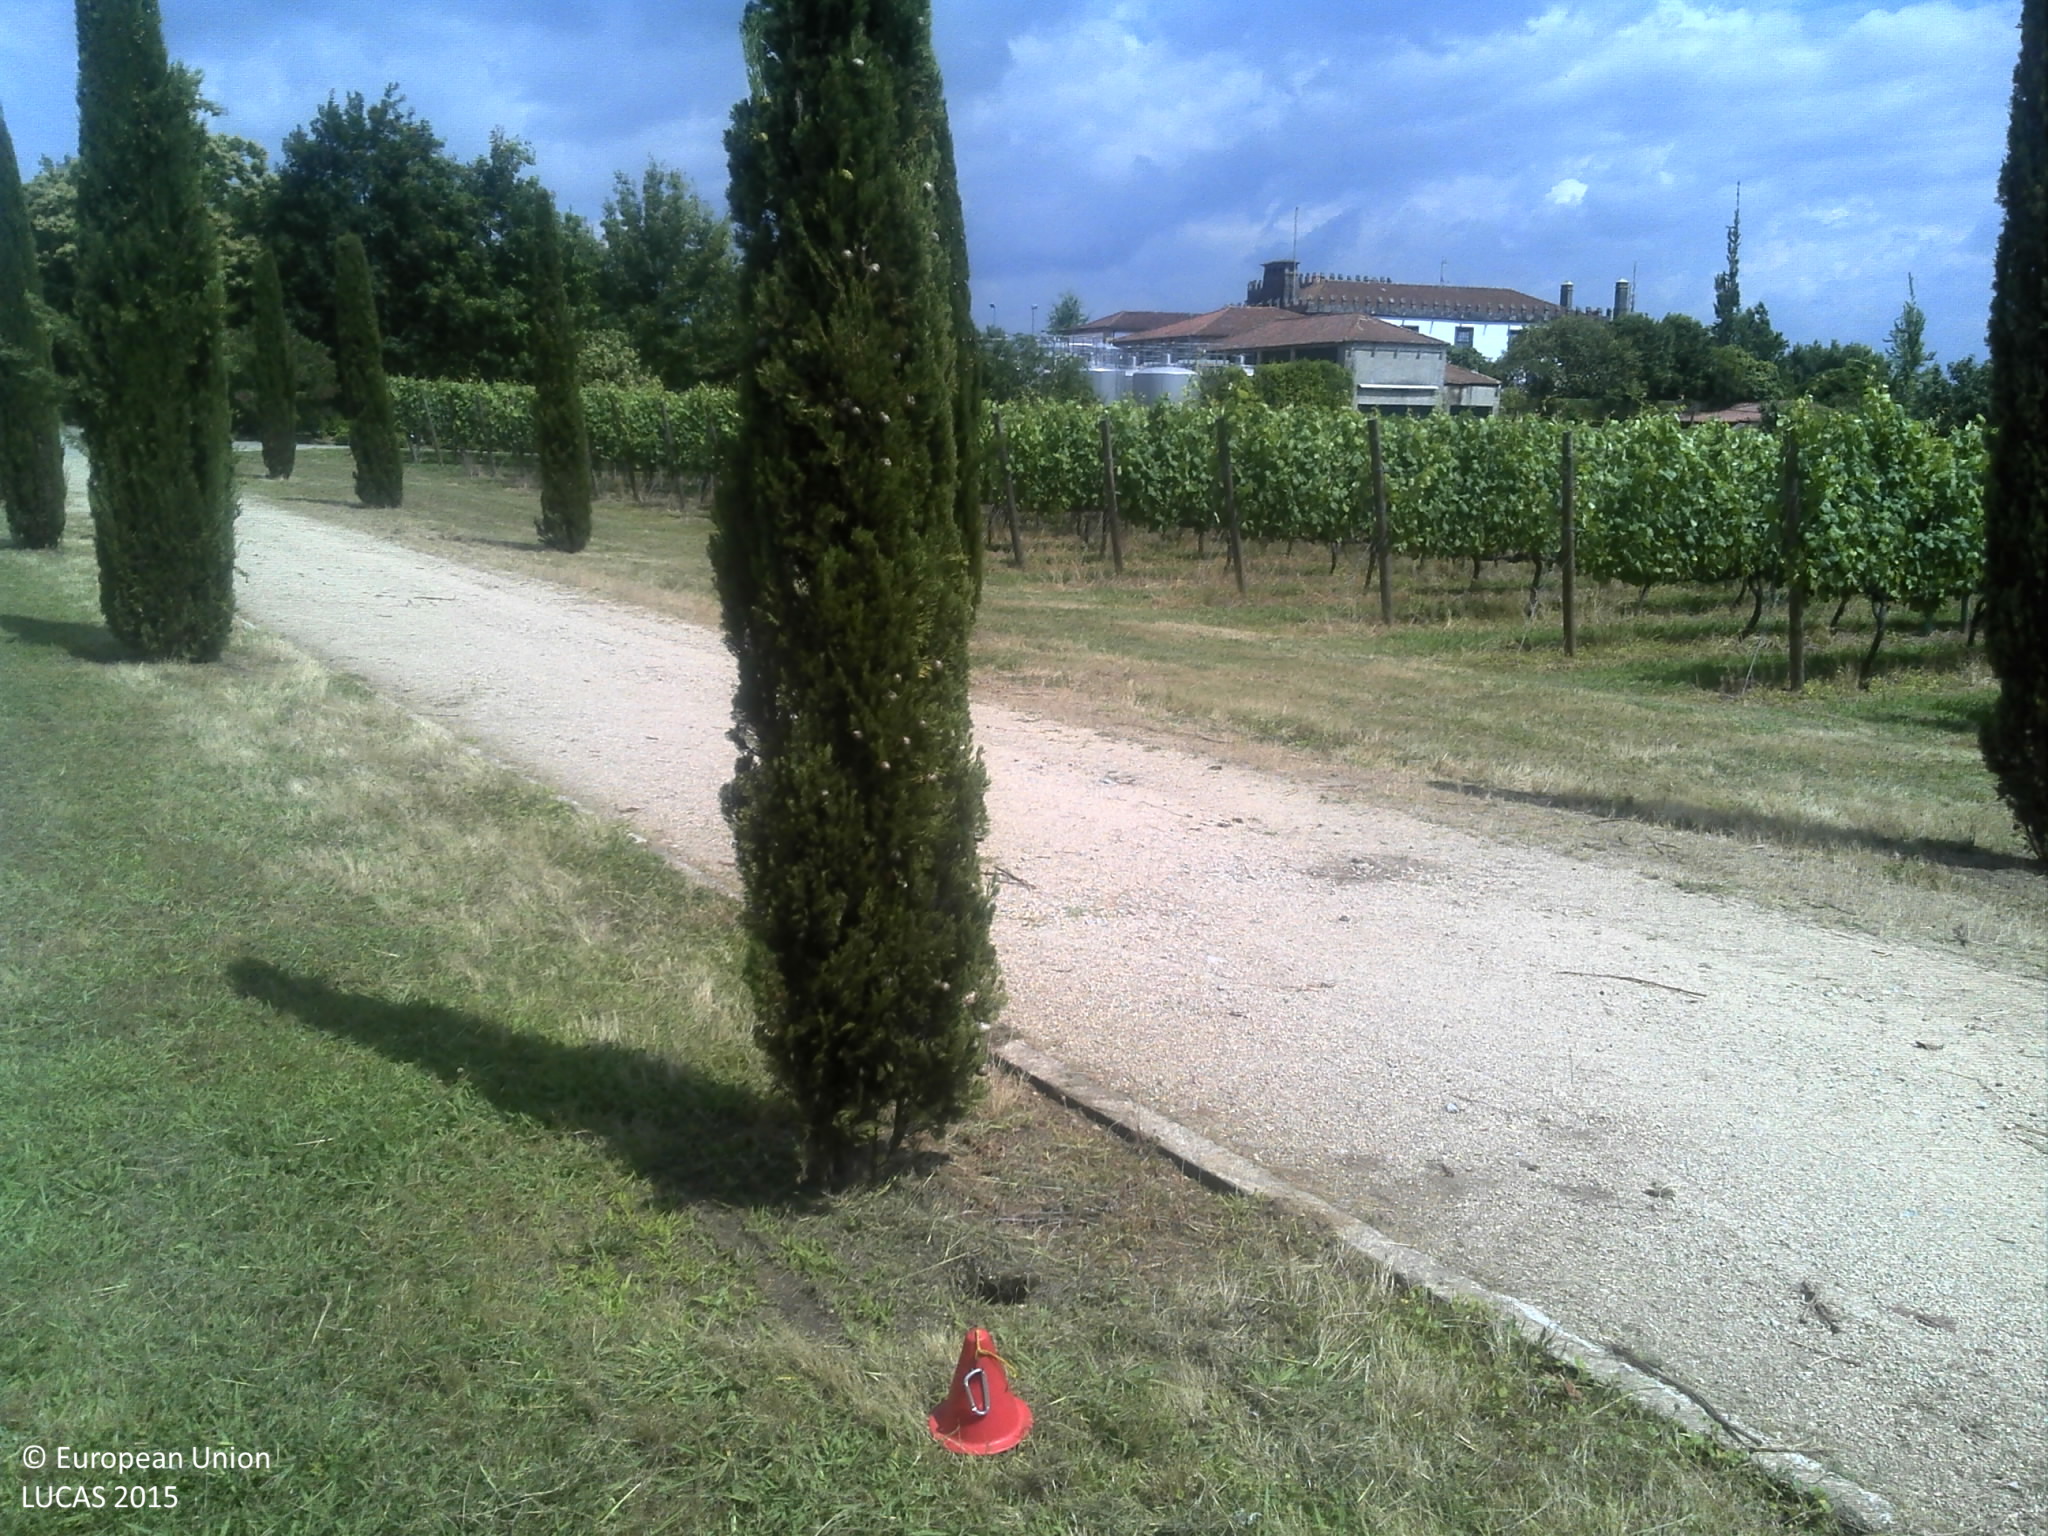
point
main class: Grassland
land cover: Grassland without tree/shrub cover
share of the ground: > 75 %
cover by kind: herbaceous plants 85 %, unconsolidated bare surface 15 %
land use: Agriculture (excluding fallow land and kitchen gardens)
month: June
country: PT
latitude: 41.5710
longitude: -8.5423
